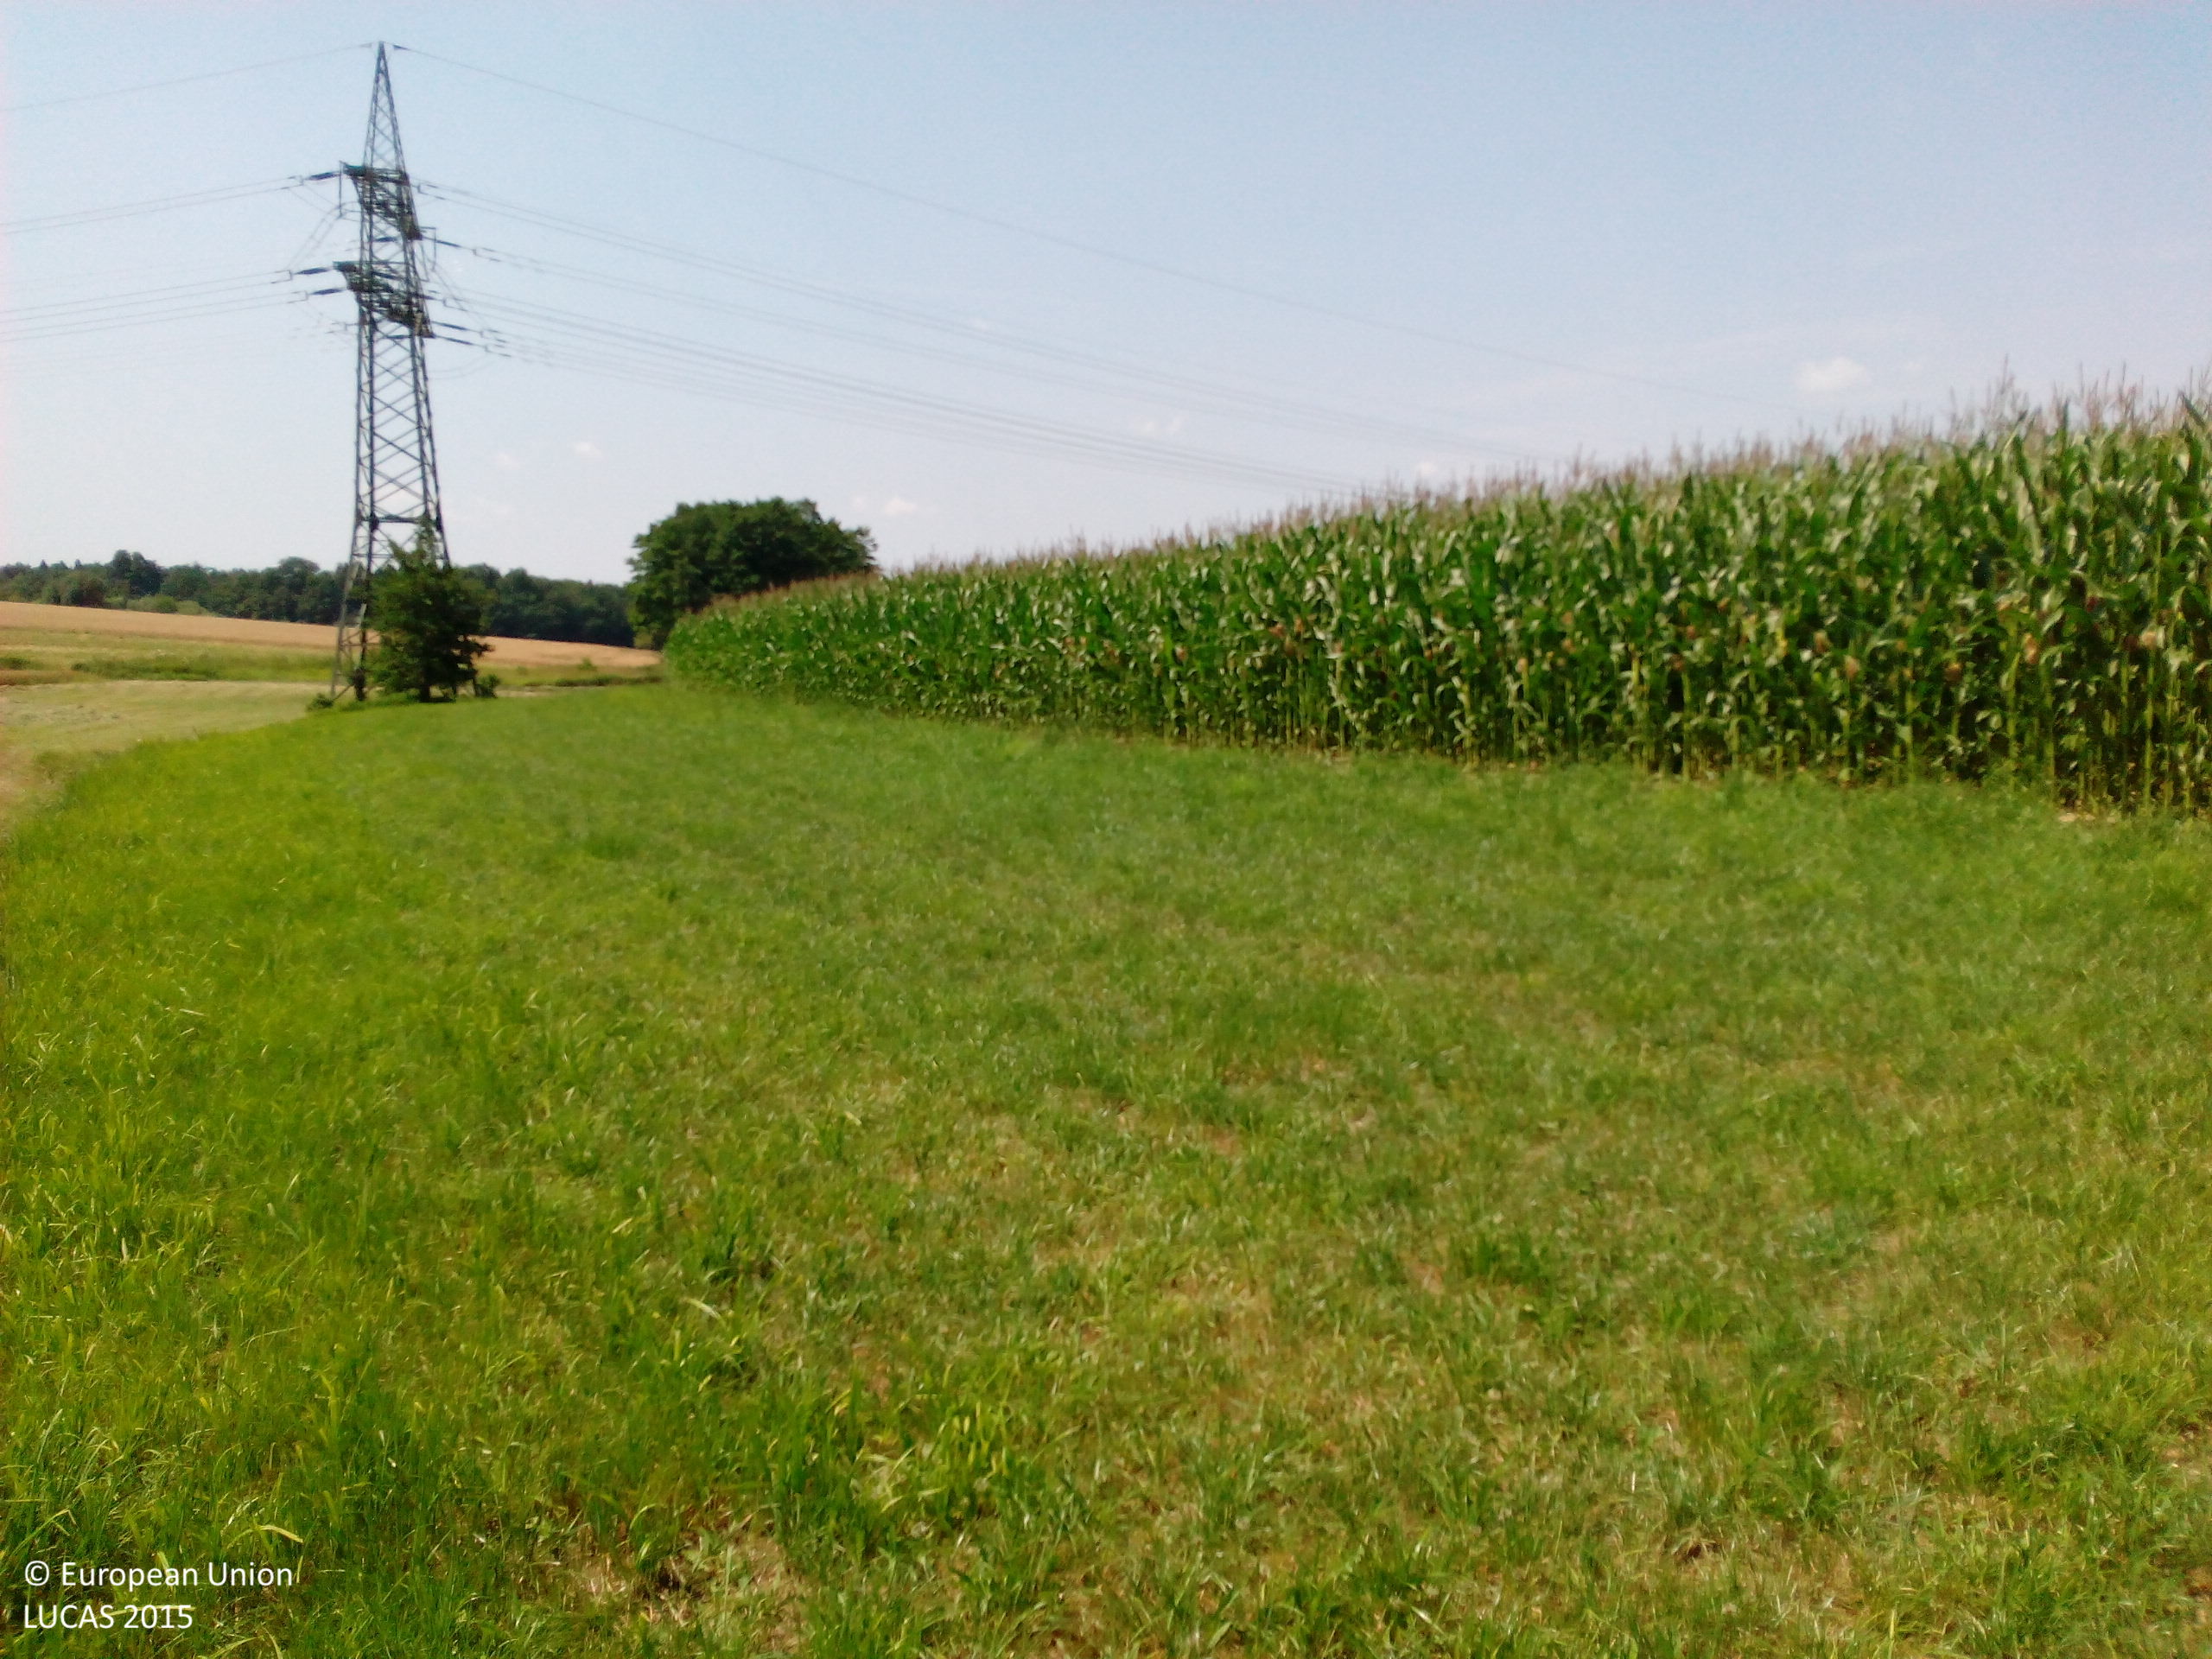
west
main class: Grassland
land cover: Grassland without tree/shrub cover
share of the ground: 50 - 75 %
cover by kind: herbaceous plants 70 %, unconsolidated bare surface 30 %
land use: Agriculture (excluding fallow land and kitchen gardens)
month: July
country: DE
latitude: 48.4733
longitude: 12.9074
